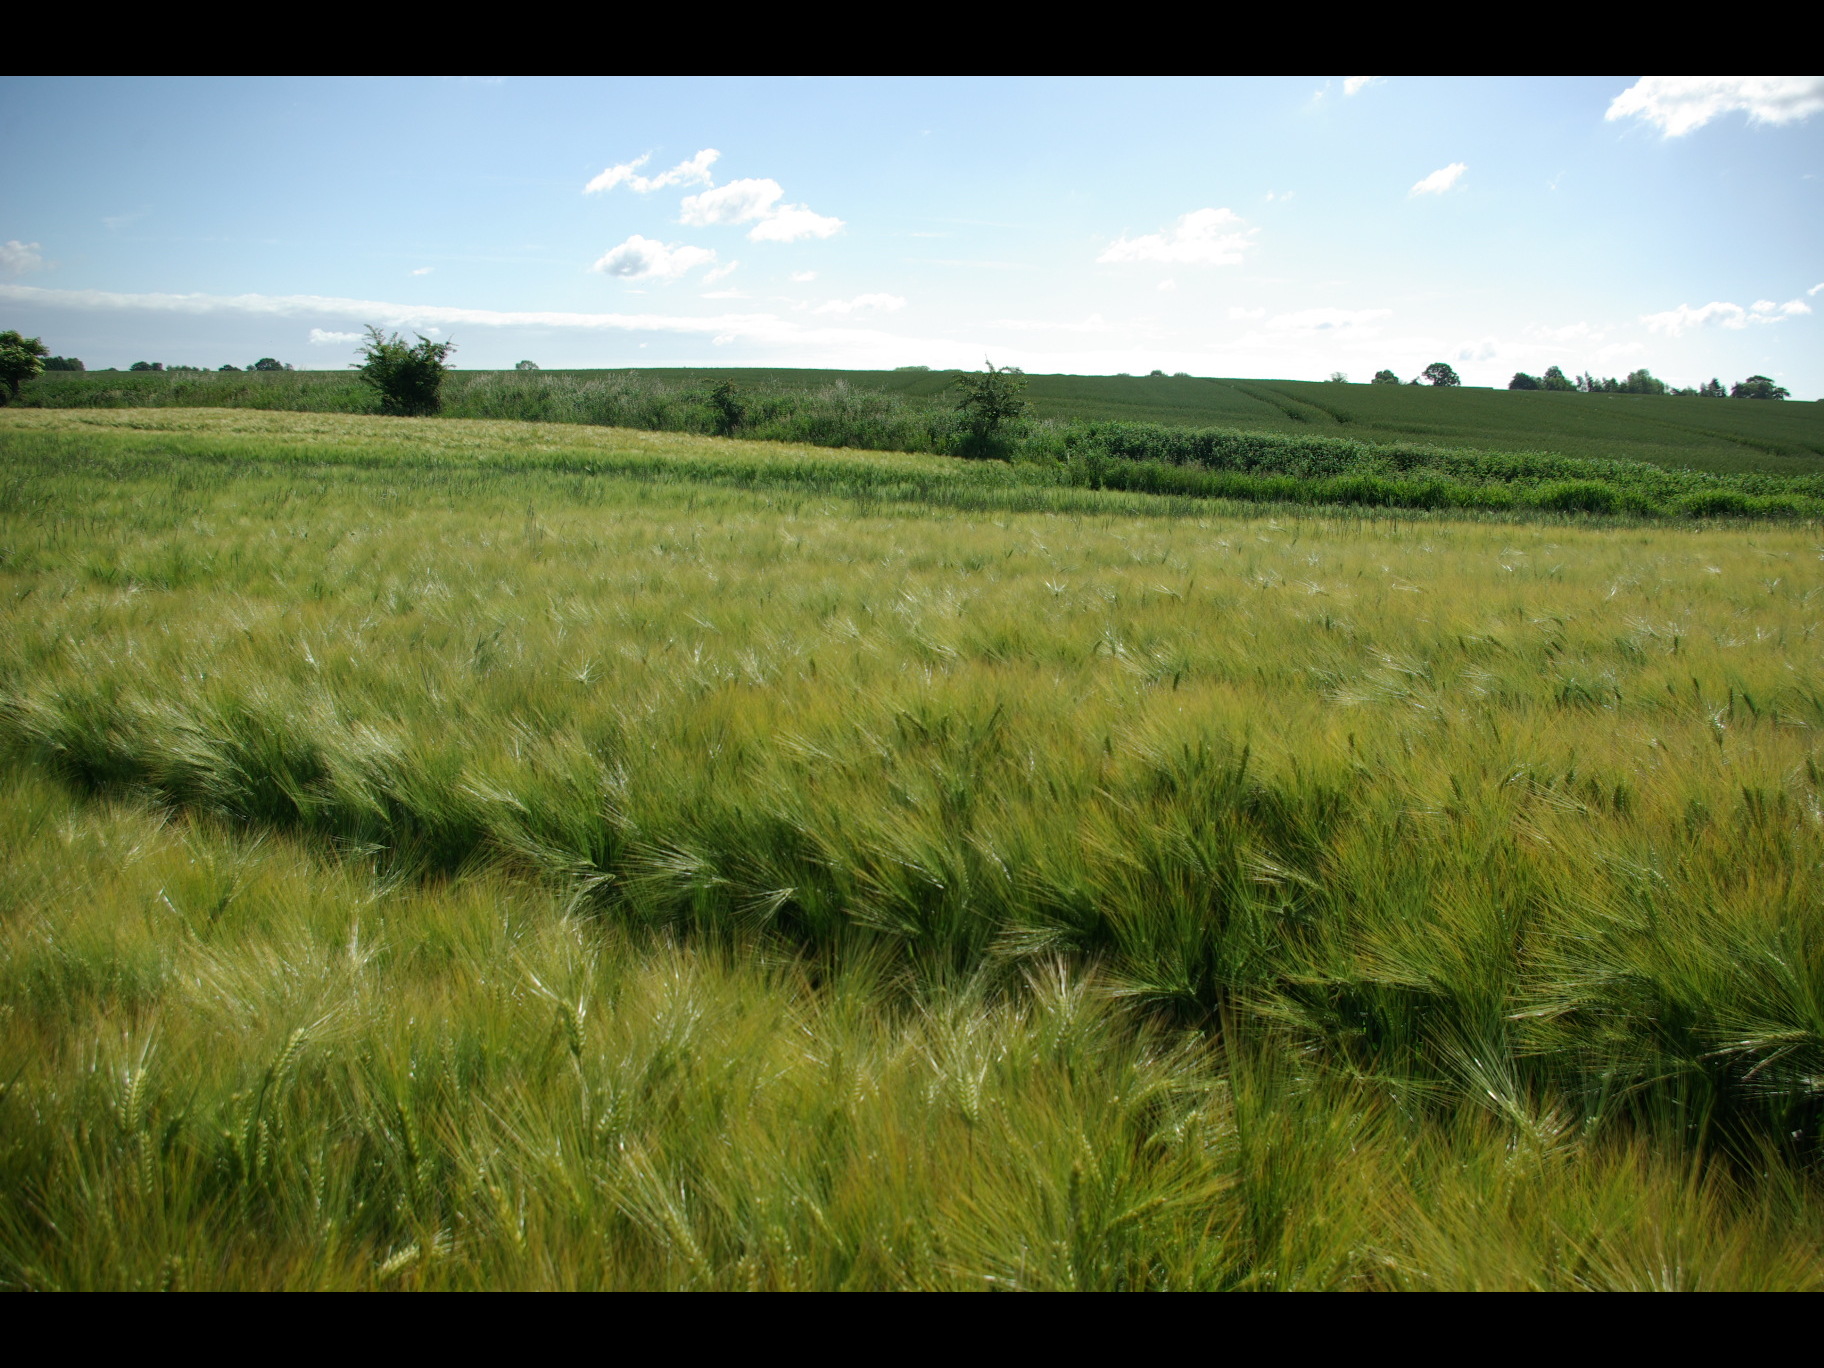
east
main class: Cropland
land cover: Barley
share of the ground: > 75 %
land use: Agriculture (excluding fallow land and kitchen gardens)
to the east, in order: Barley; Other bare soil; Barley; Spontaneously vegetated surfaces; Common wheat
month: June
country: DE
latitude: 54.3544
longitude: 9.9231
